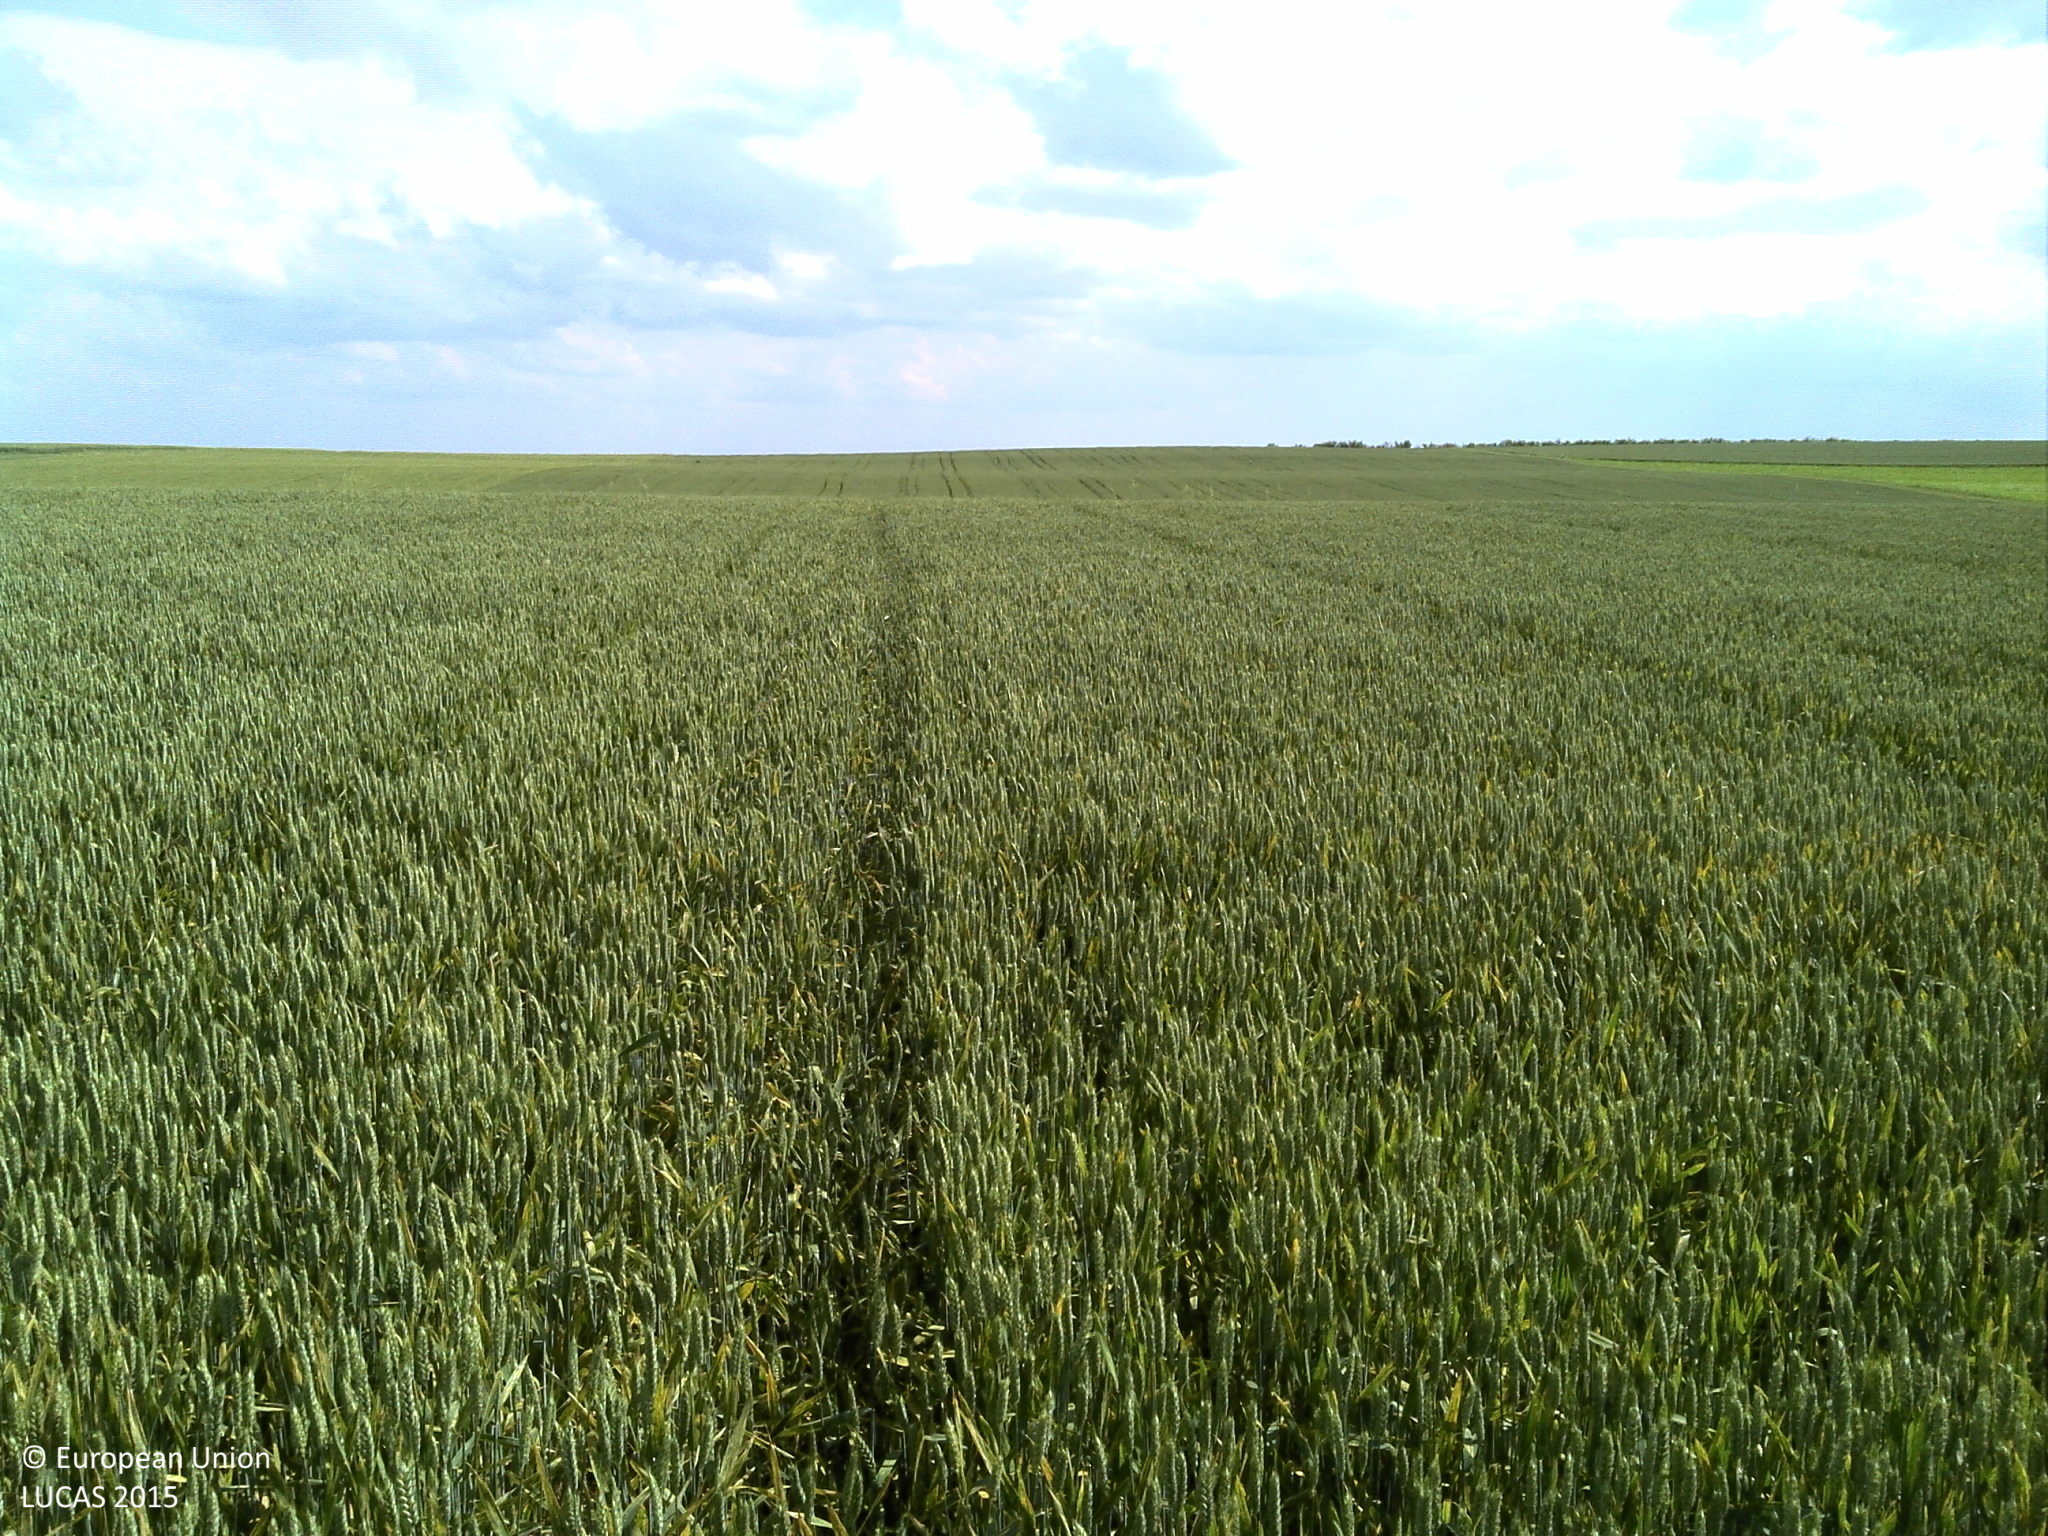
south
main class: Cropland
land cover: Common wheat
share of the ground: > 75 %
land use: Agriculture (excluding fallow land and kitchen gardens)
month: May
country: HR
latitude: 45.5217
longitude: 18.9583
